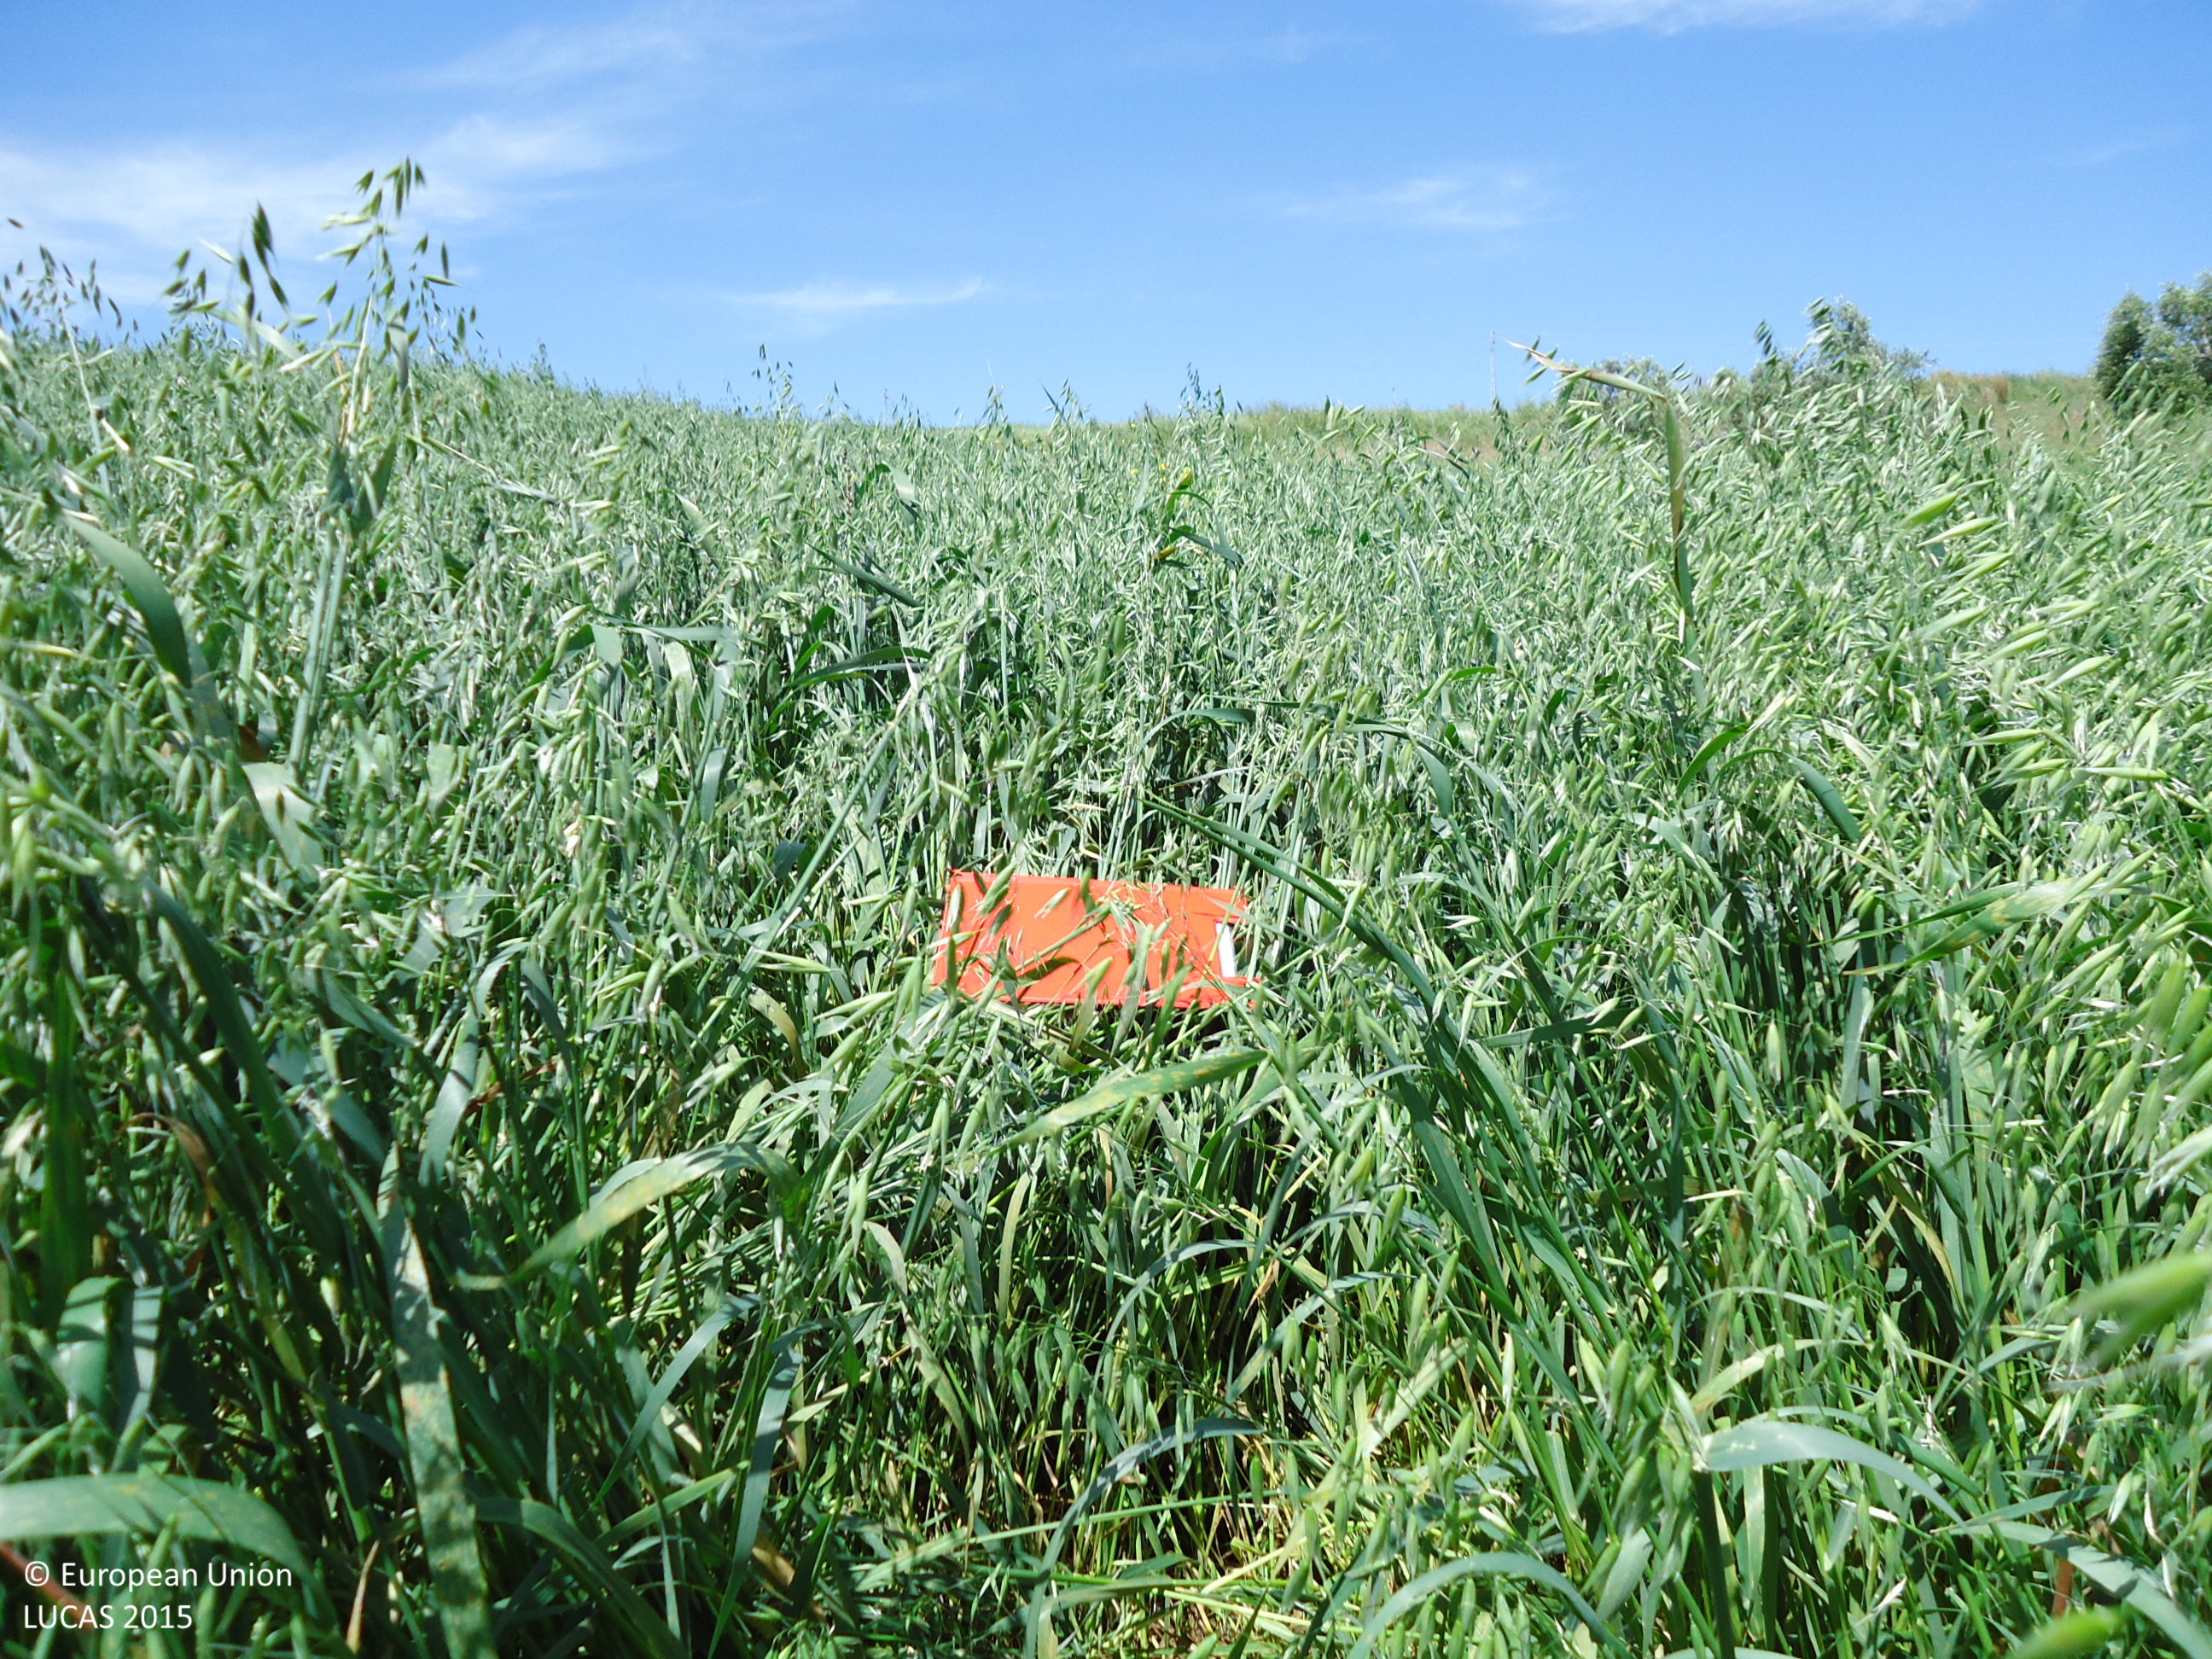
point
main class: Cropland
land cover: Oats
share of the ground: > 75 %
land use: Agriculture (excluding fallow land and kitchen gardens)
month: April
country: ES
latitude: 36.8492
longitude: -5.4253
